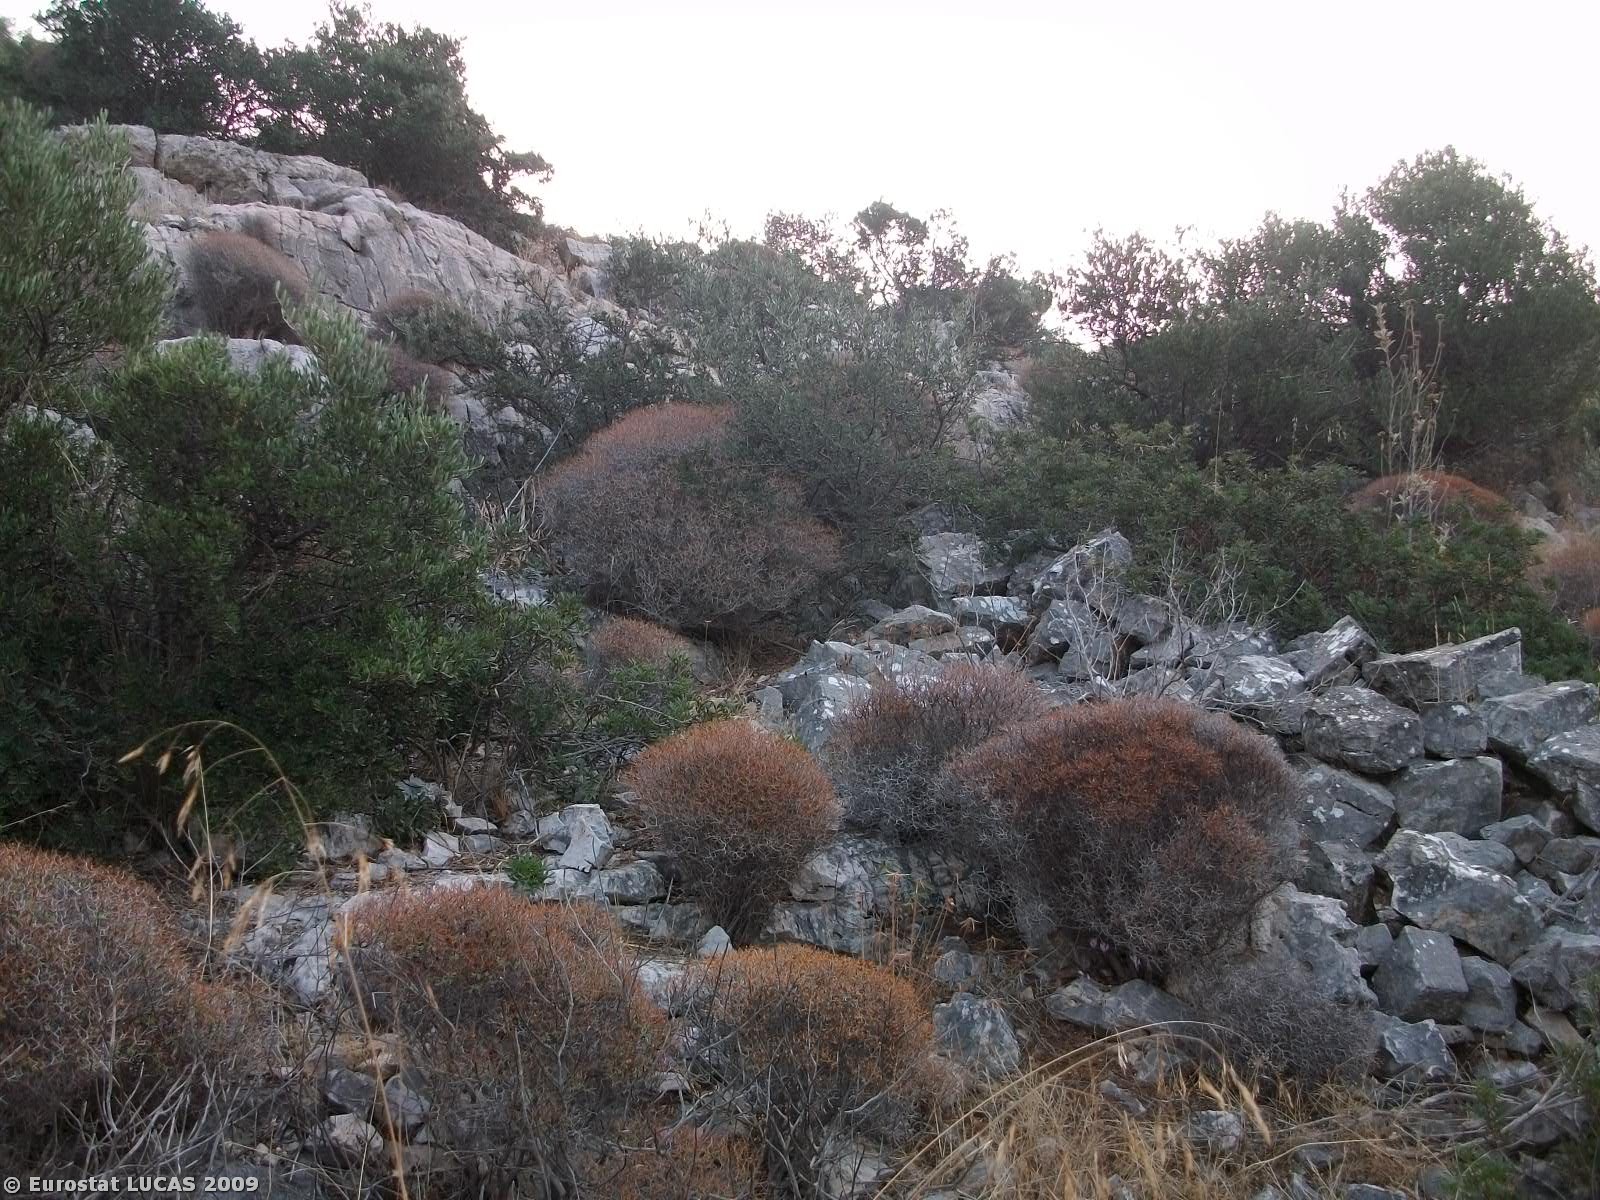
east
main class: Shrubland
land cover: Shrubland with sparse tree cover
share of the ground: 50 - 75 %
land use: Unused
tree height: < 5 m
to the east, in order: Shrubland with sparse tree cover; Rock outcrops; Shrubland with sparse tree cover; Electric lines; Paved roads, cycling and walking lanes; Grassland with sparse tree/shrub cover
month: October
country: GR
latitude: 37.8158
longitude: 23.8263
